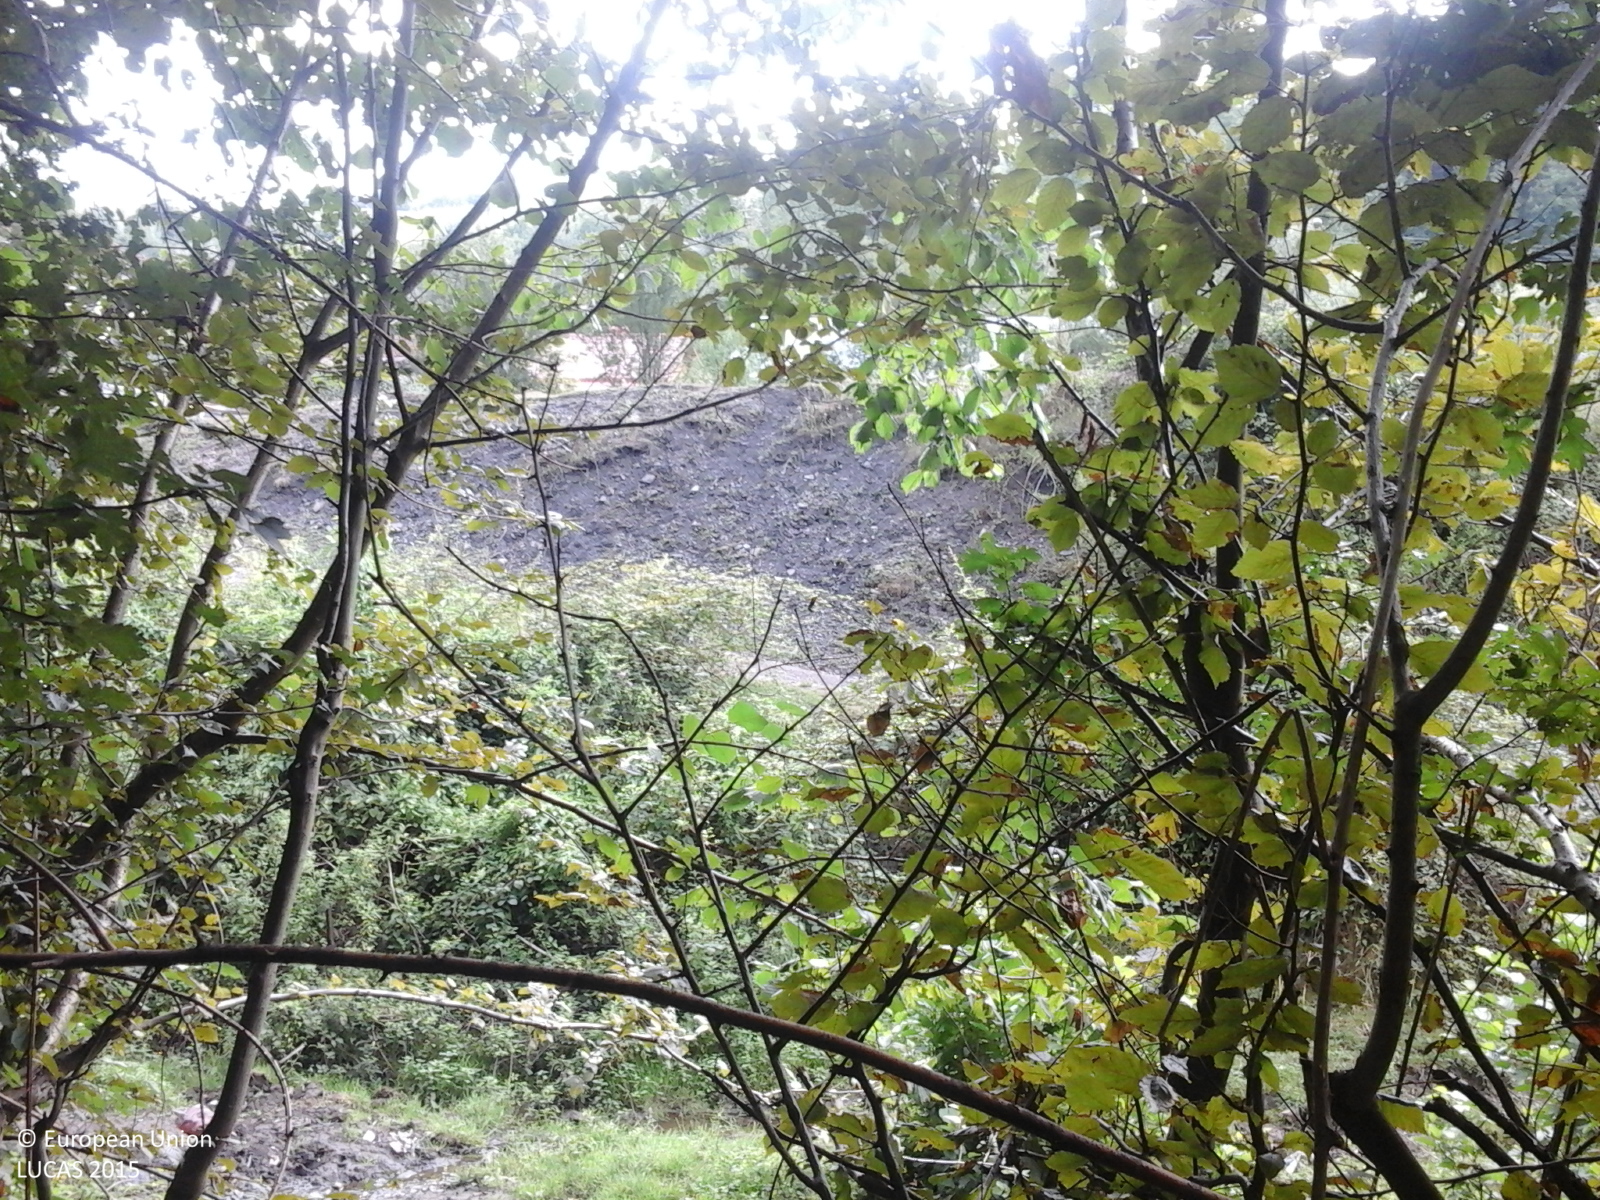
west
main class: Woodland
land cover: Broadleaved woodland
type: beech forest
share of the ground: > 75 %
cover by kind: broadleaved forest trees 100 %
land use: Forestry
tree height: > 5 m
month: August
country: RO
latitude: 45.2746
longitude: 21.9807
